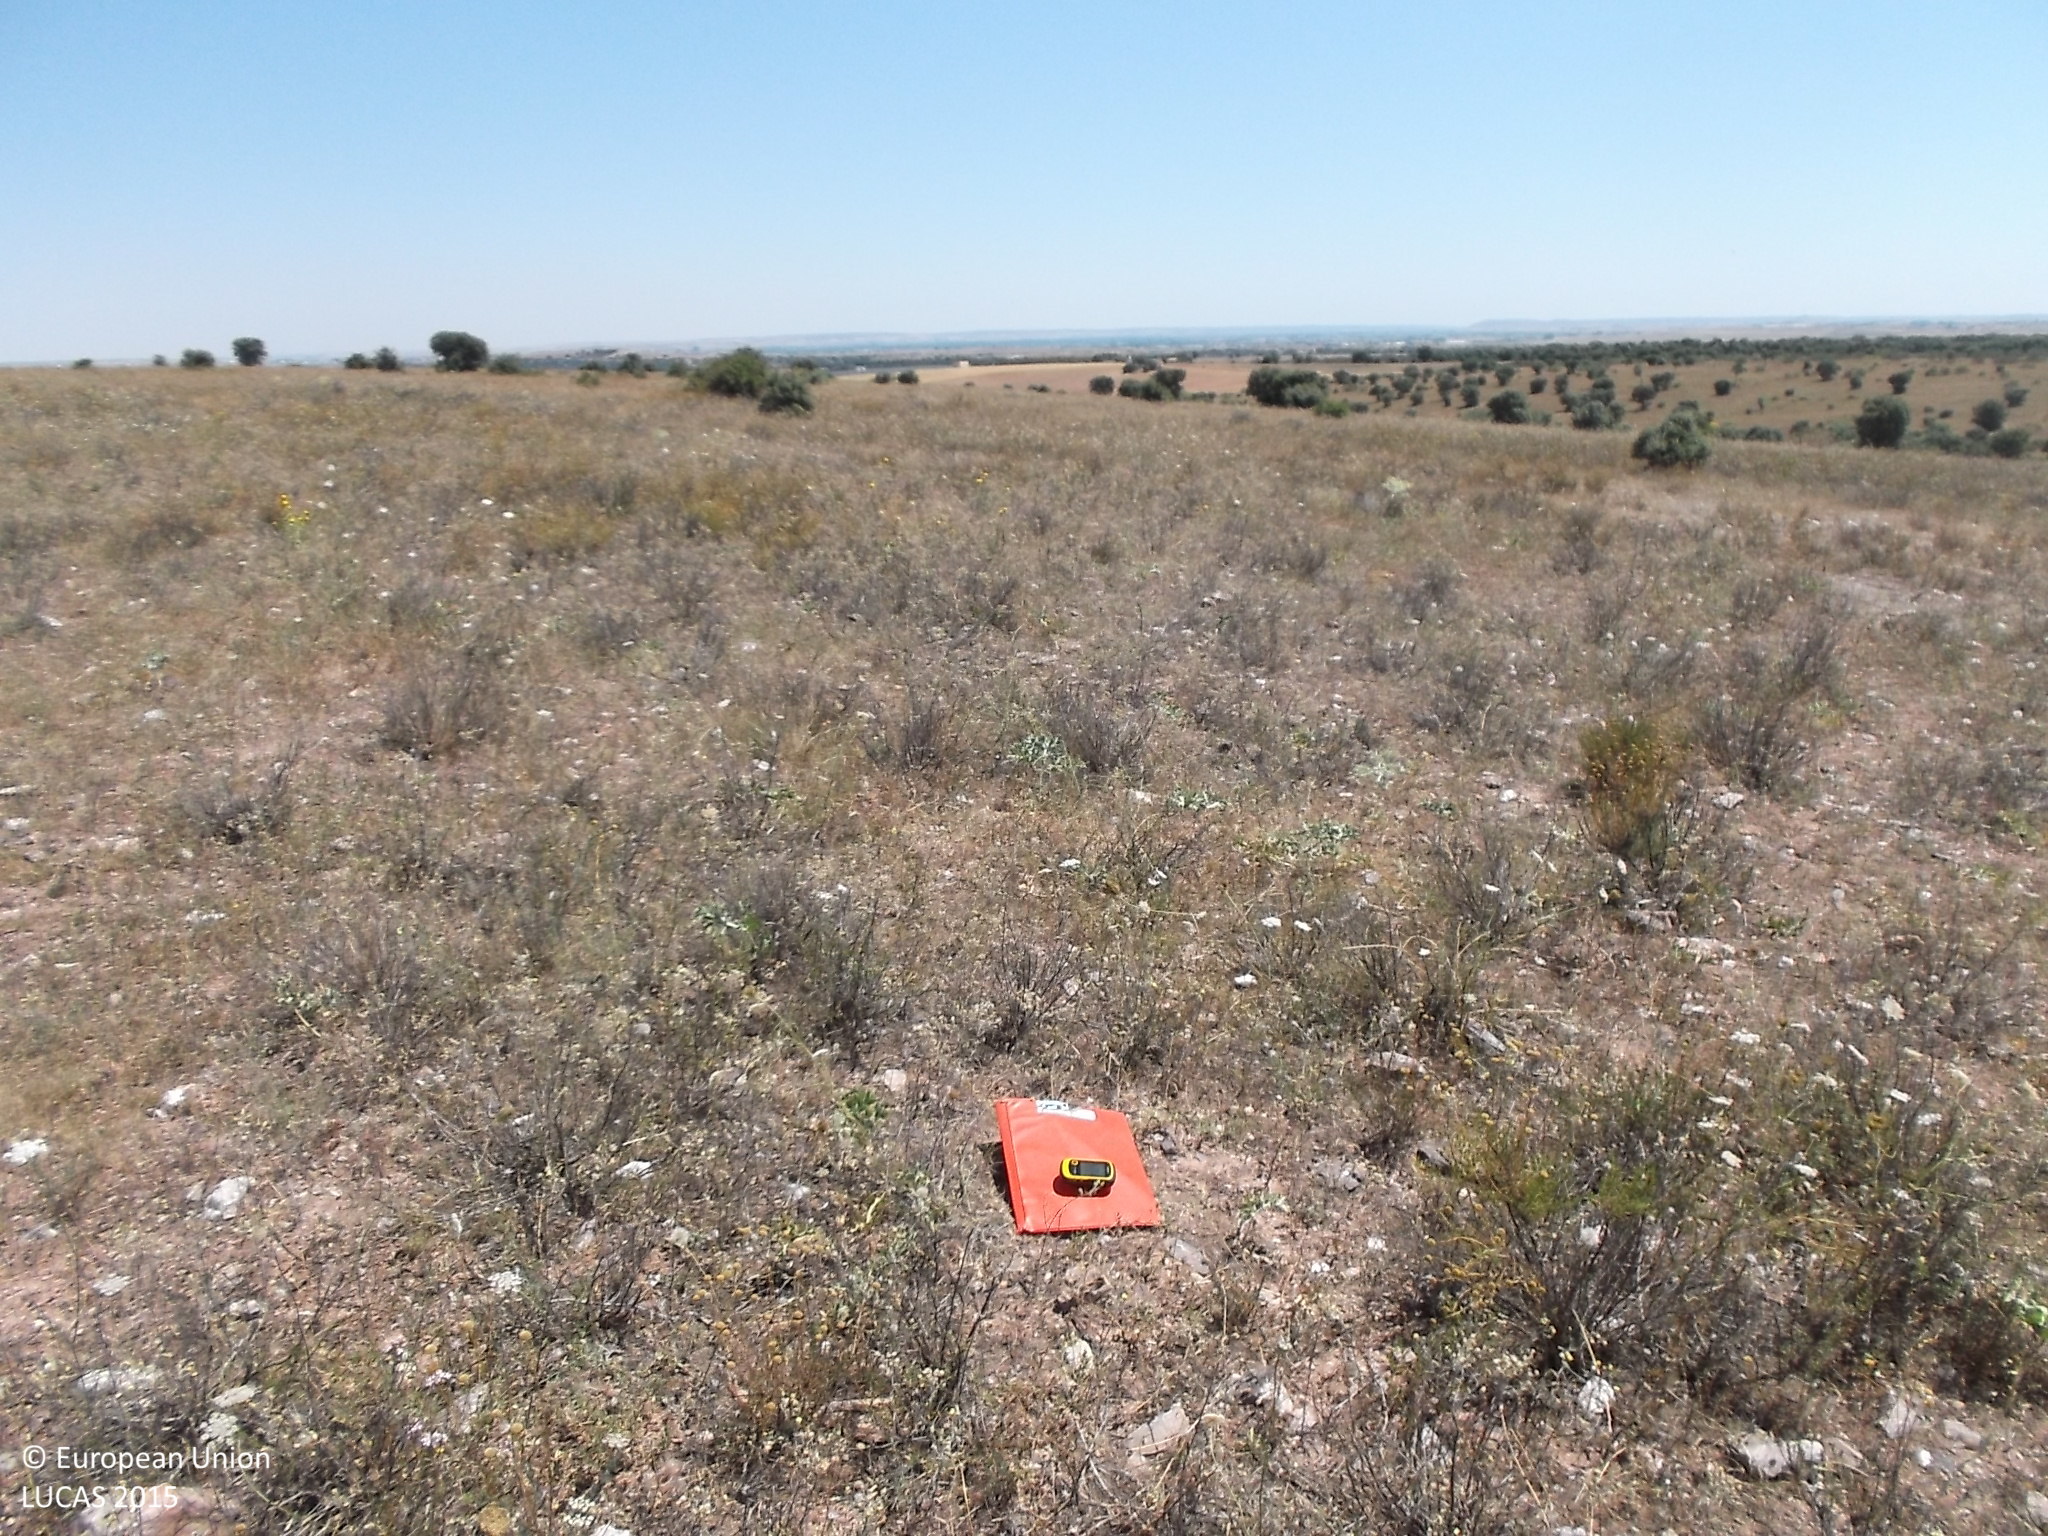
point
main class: Shrubland
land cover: Shrubland without tree cover
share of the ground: > 75 %
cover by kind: shrubs 100 %
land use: Agriculture (excluding fallow land and kitchen gardens)
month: July
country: ES
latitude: 41.4551
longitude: -5.8297
